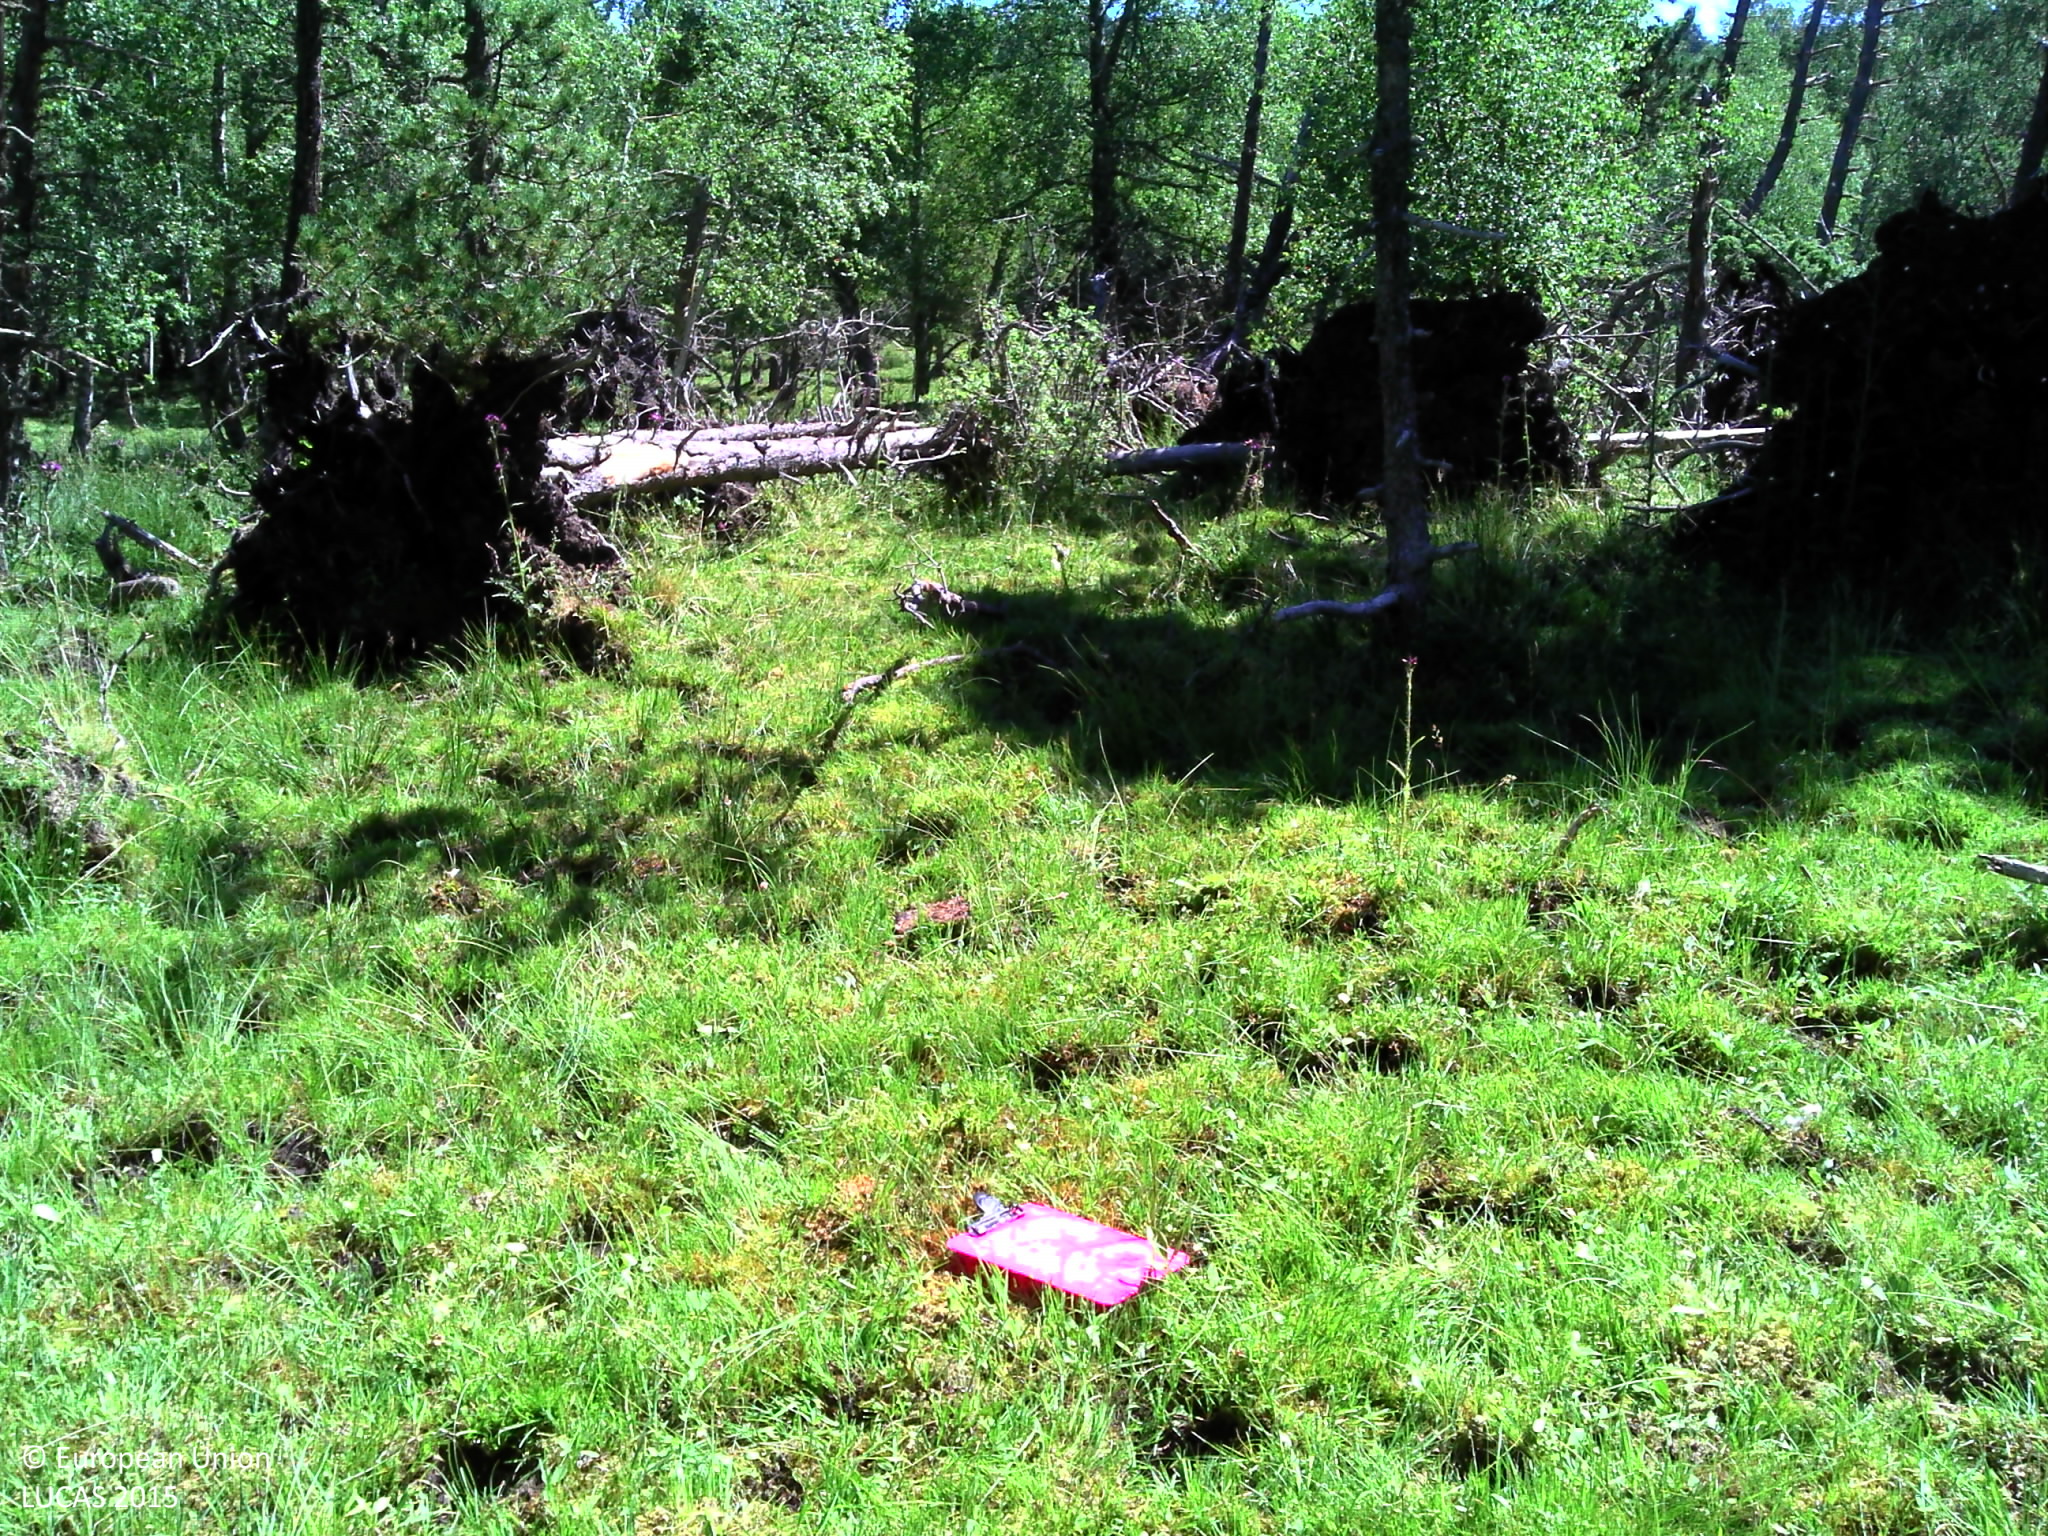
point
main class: Woodland
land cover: Pine dominated mixed woodland
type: hemiboreal forest and nemoral coniferous forest and mixed broadleaved-coniferous forest
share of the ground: > 75 %
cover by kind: broadleaved forest trees 40 %, coniferous forest trees 35 %, herbaceous plants 20 %
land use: Forestry
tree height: > 5 m
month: July
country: FR
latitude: 42.6728
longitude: 2.1155
